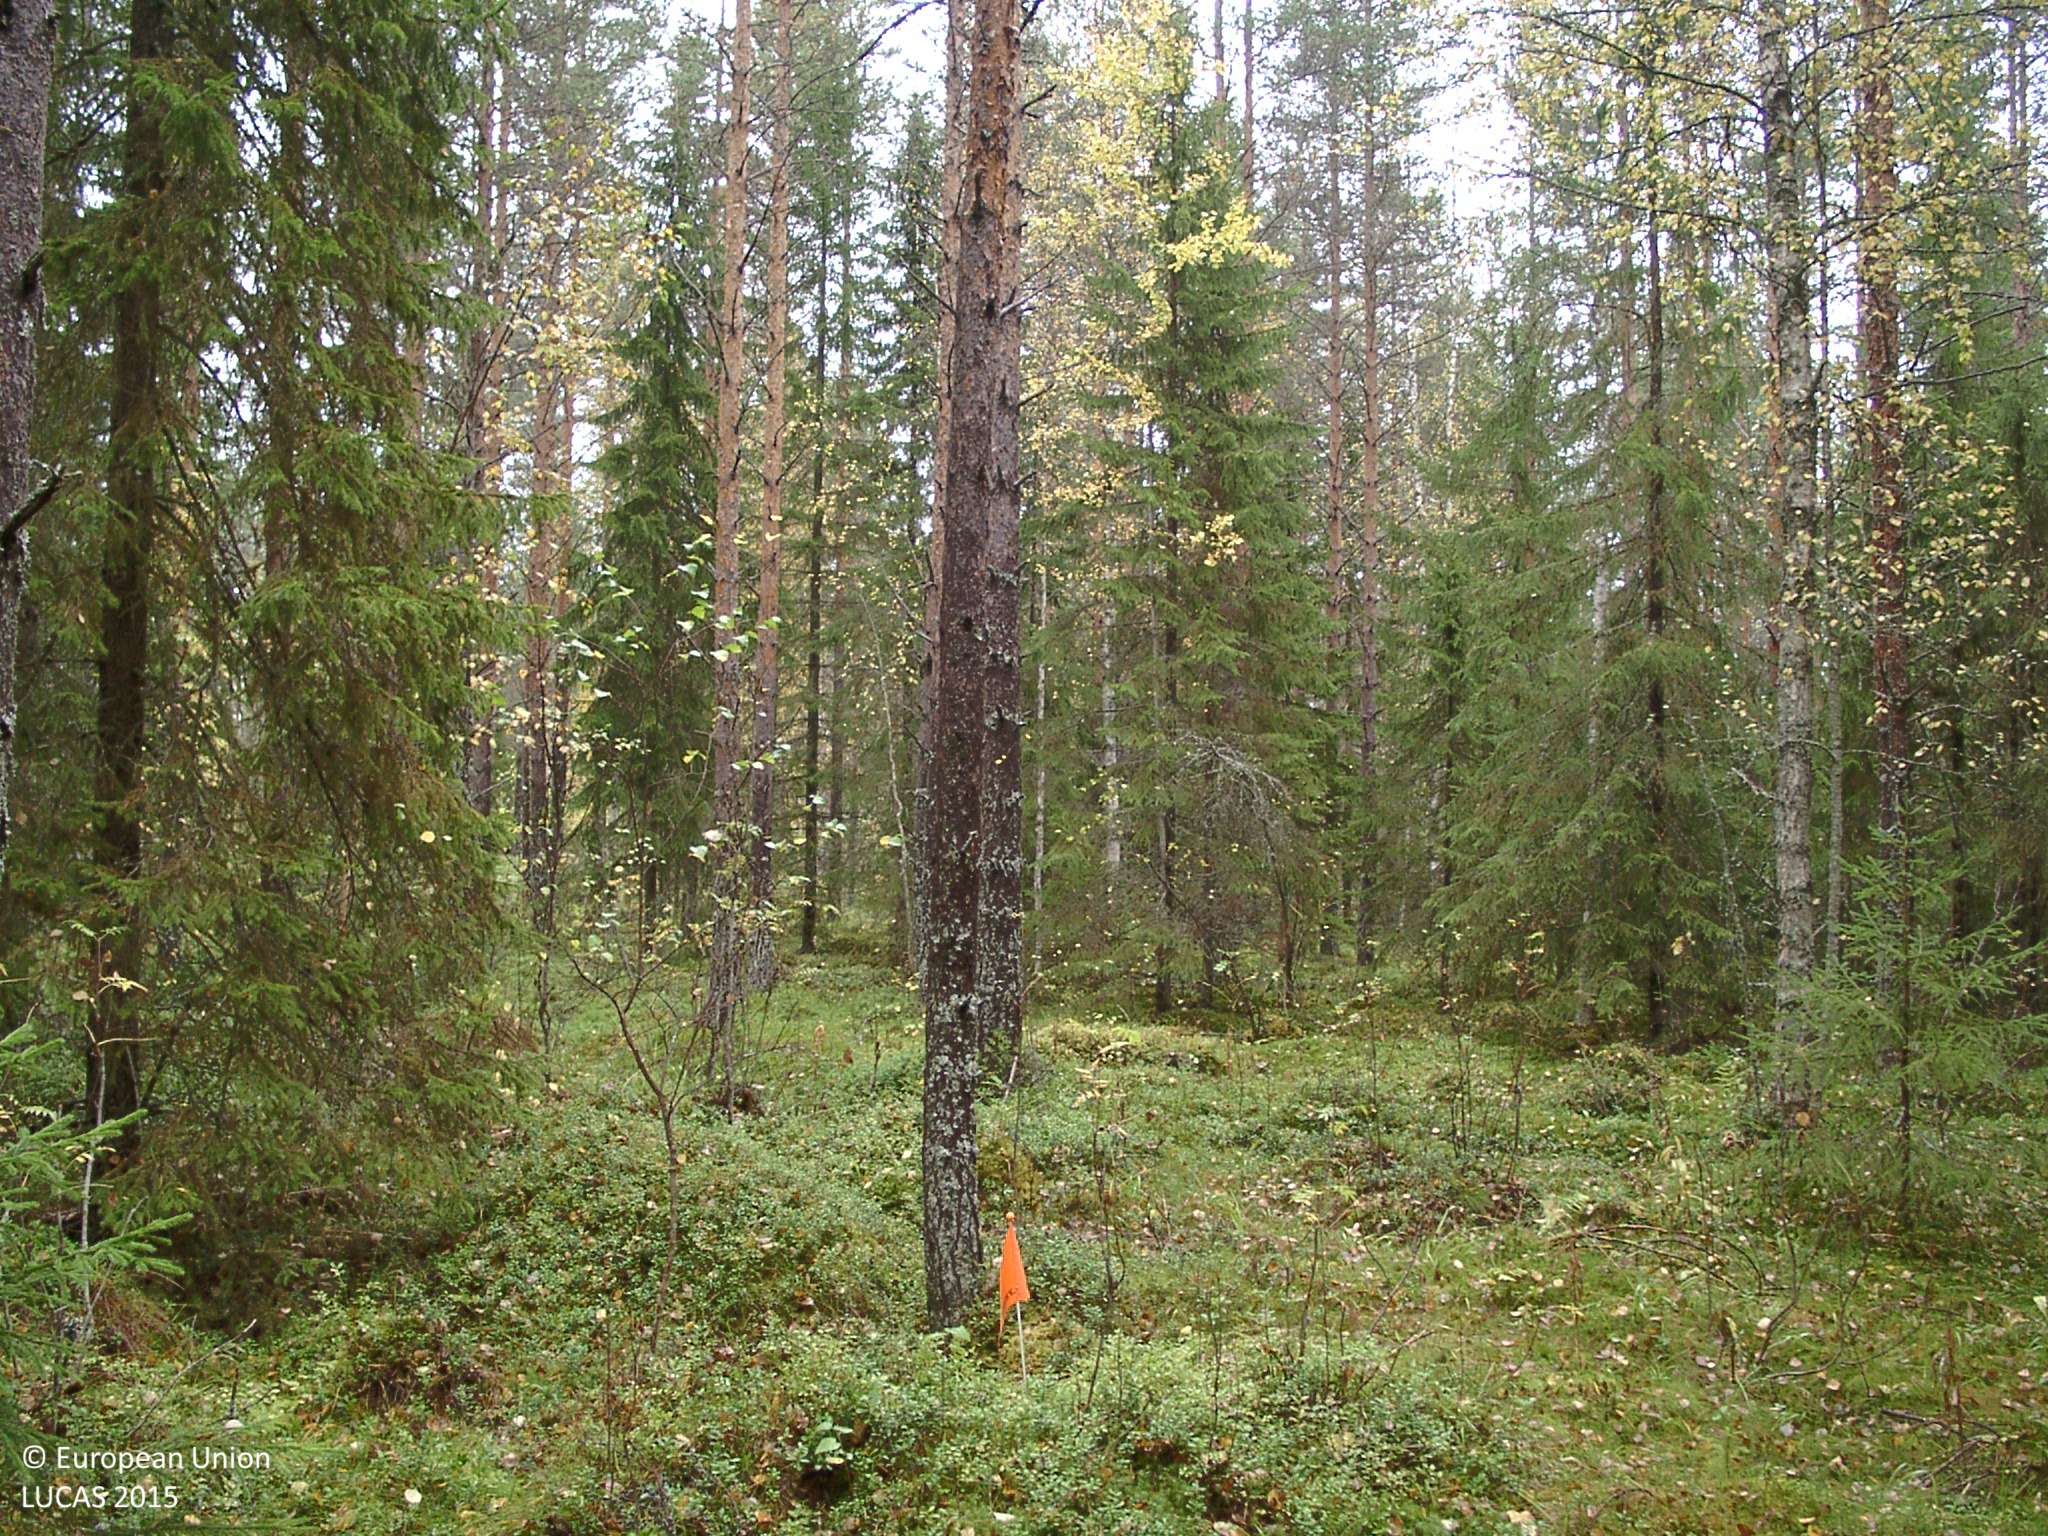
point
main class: Woodland
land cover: Other mixed woodland
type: boreal forest
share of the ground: 50 - 75 %
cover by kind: coniferous forest trees 40 %, shrubs 20 %, broadleaved forest trees 15 %, lichens and mosses 15 %, herbaceous plants 10 %
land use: Forestry
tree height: > 5 m
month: September
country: FI
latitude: 62.8335
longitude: 25.5200
